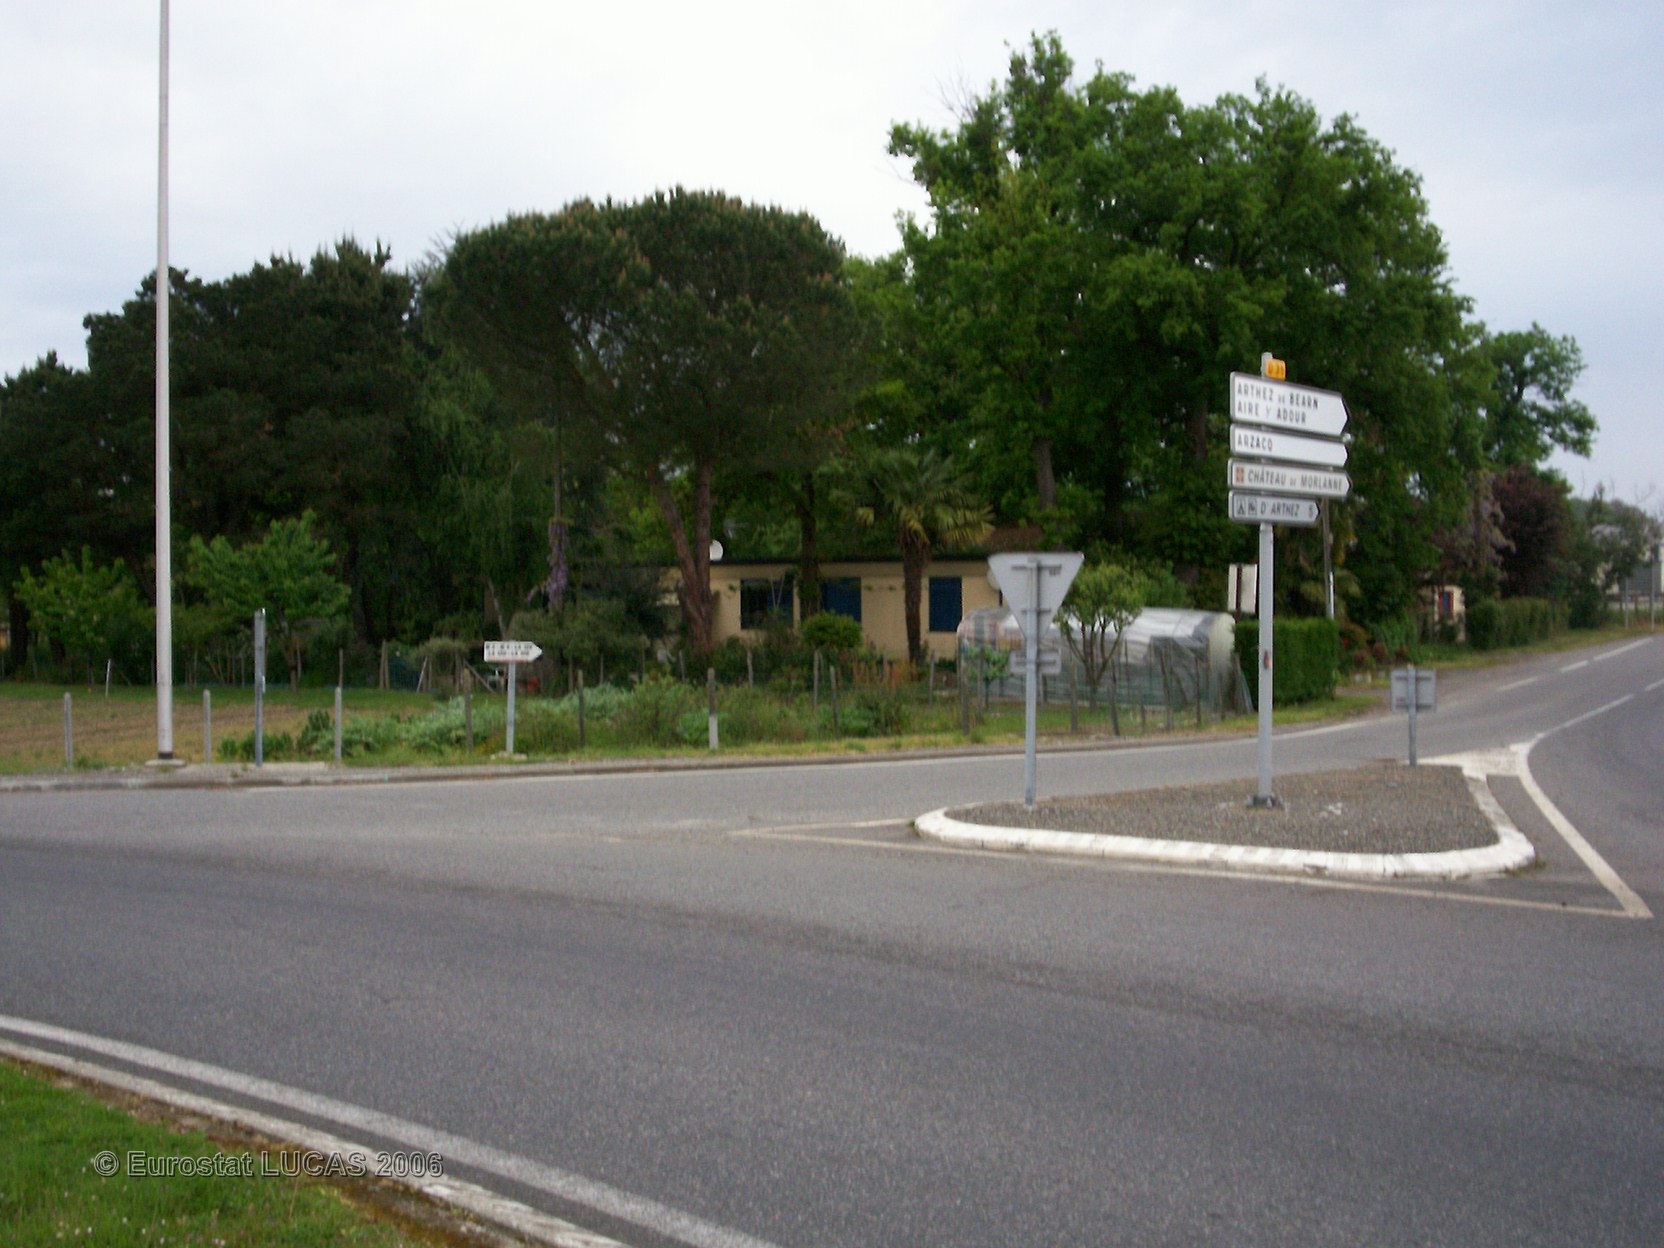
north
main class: Grassland
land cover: Grassland with sparse tree/shrub cover
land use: Road transport
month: April
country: FR
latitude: 43.4197
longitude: -0.6442
